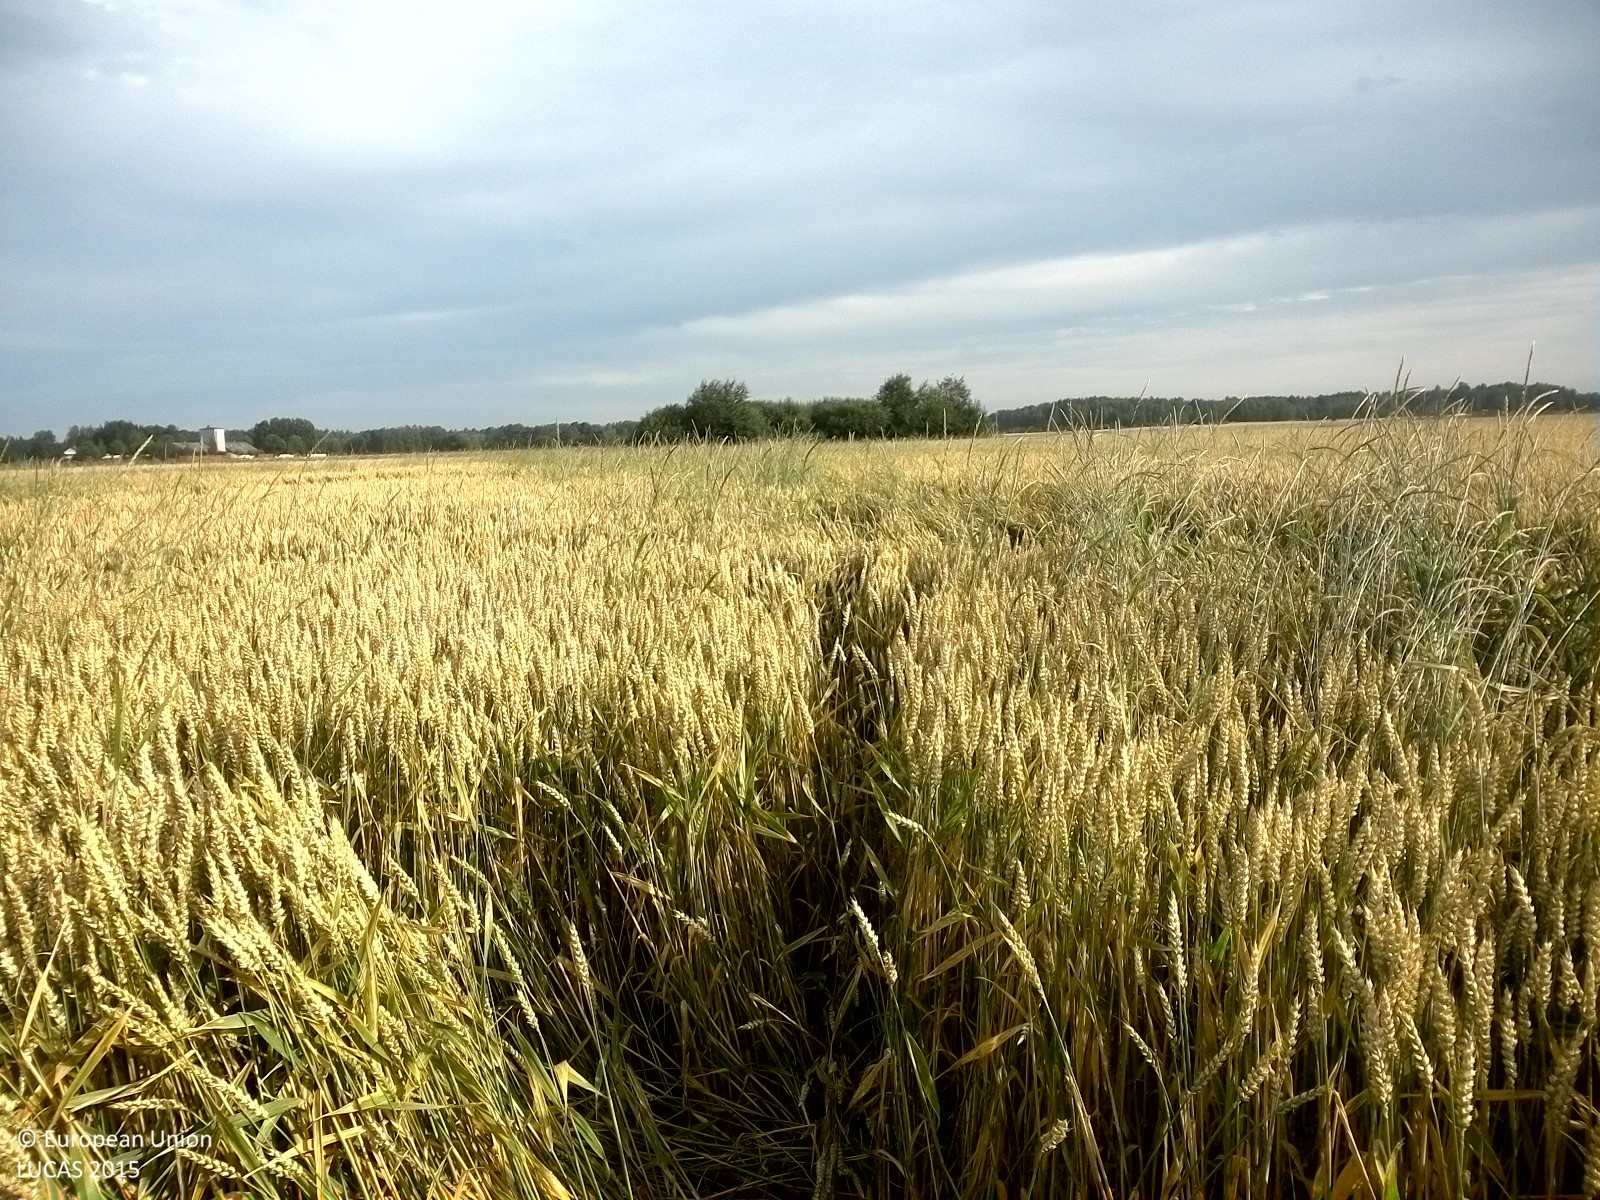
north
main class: Cropland
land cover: Common wheat
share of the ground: > 75 %
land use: Agriculture (excluding fallow land and kitchen gardens)
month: August
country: SE
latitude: 59.0782
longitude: 15.1041
